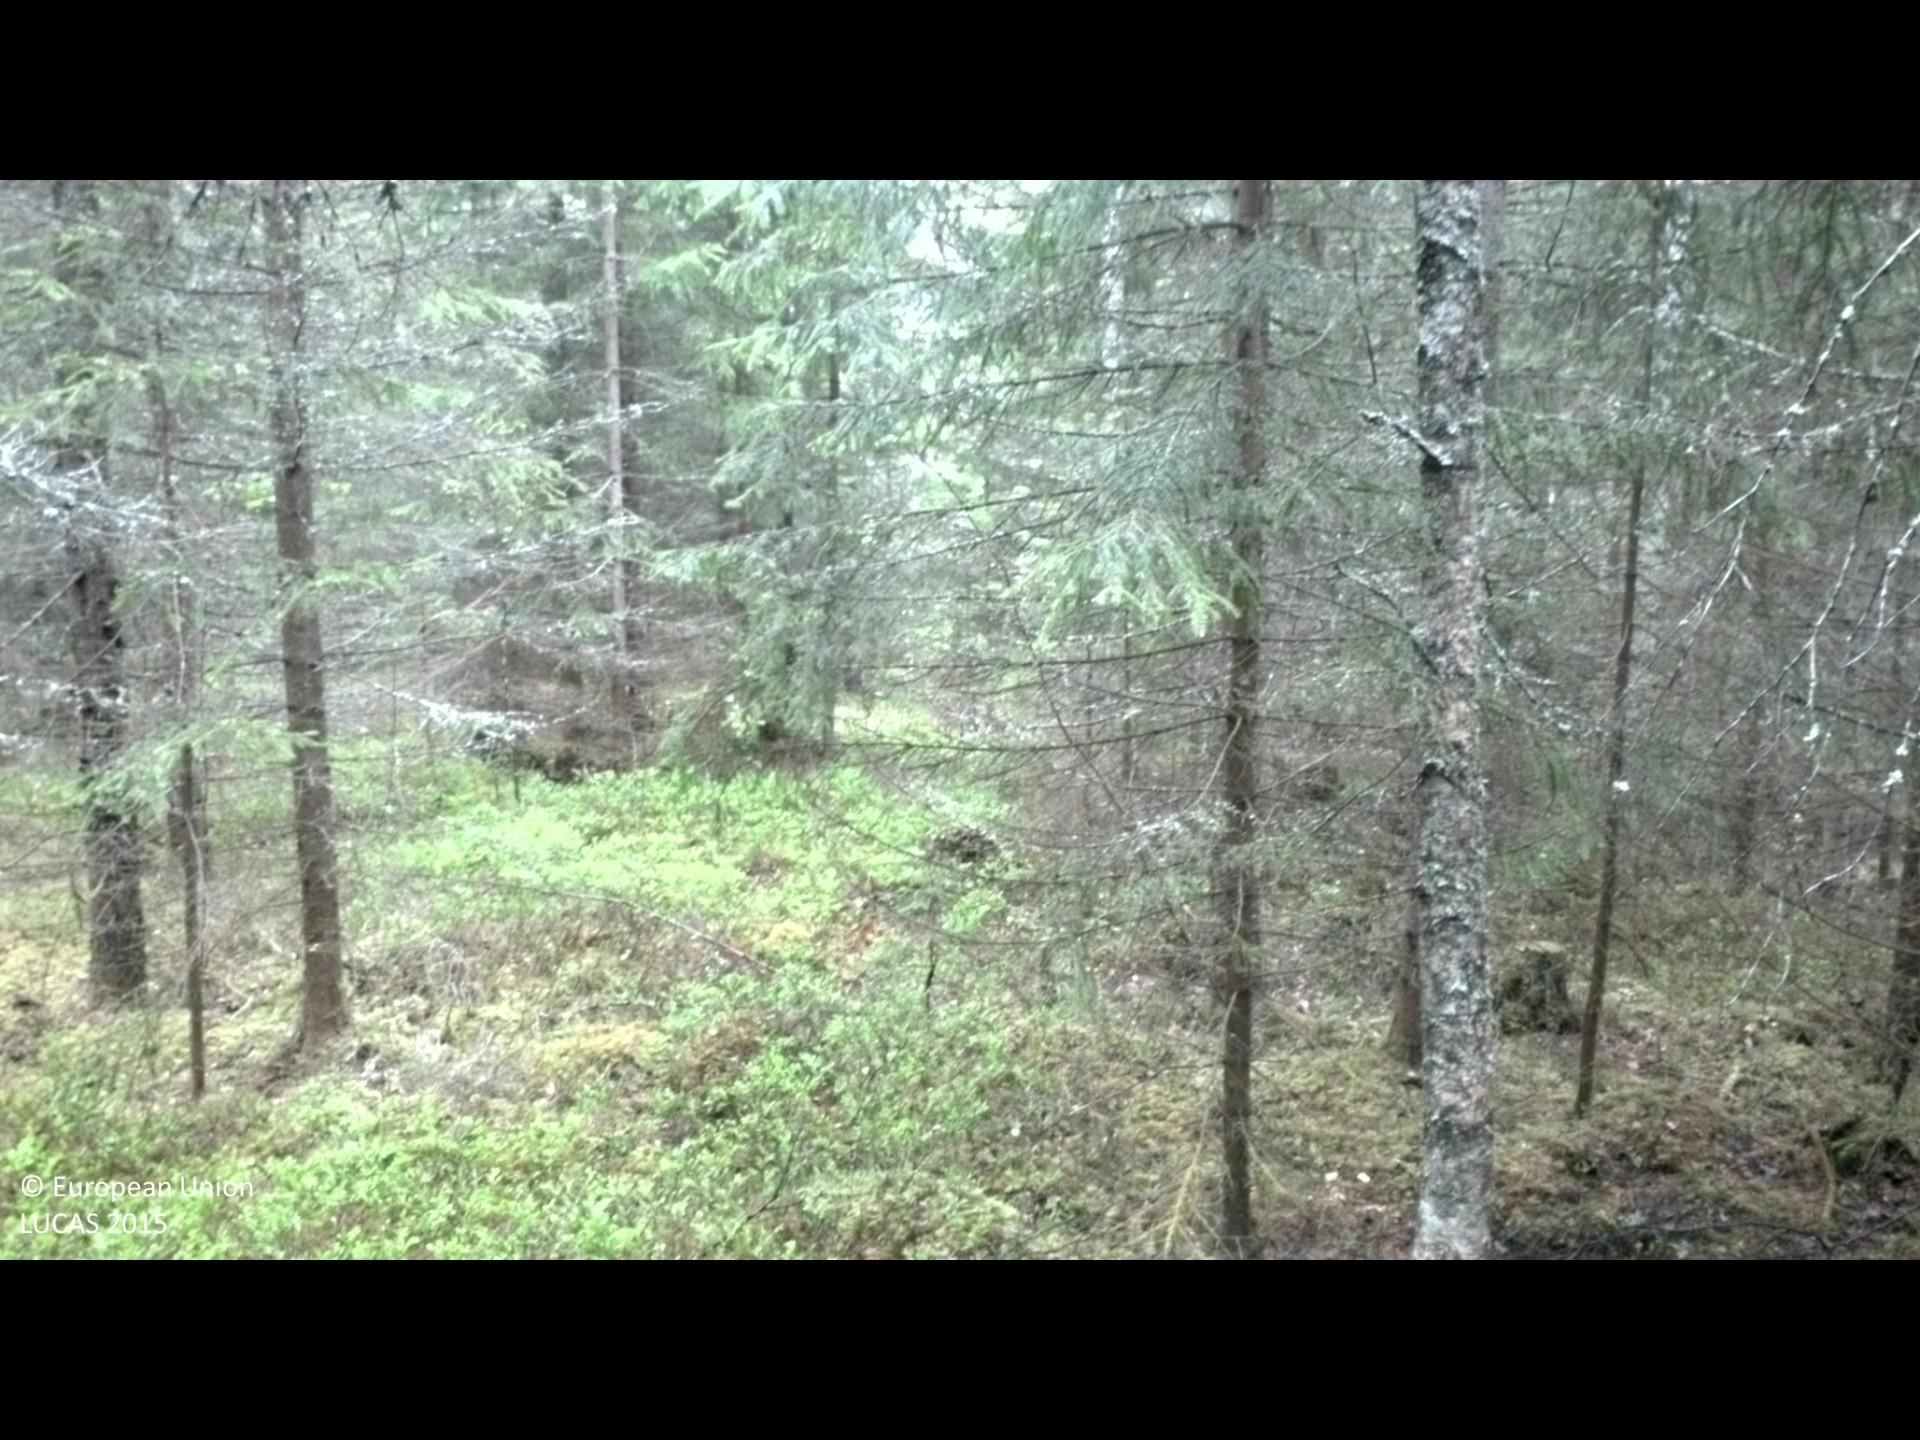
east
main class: Woodland
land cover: Spruce dominated mixed woodland
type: boreal forest
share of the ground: > 75 %
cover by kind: coniferous forest trees 60 %, broadleaved forest trees 20 %, shrubs 20 %
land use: Forestry
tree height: > 5 m
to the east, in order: Spruce dominated mixed woodland; Broadleaved woodland; Electric lines; Spruce dominated mixed woodland; Artificial constructions in urban areas
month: May
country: SE
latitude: 62.9777
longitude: 17.6915
